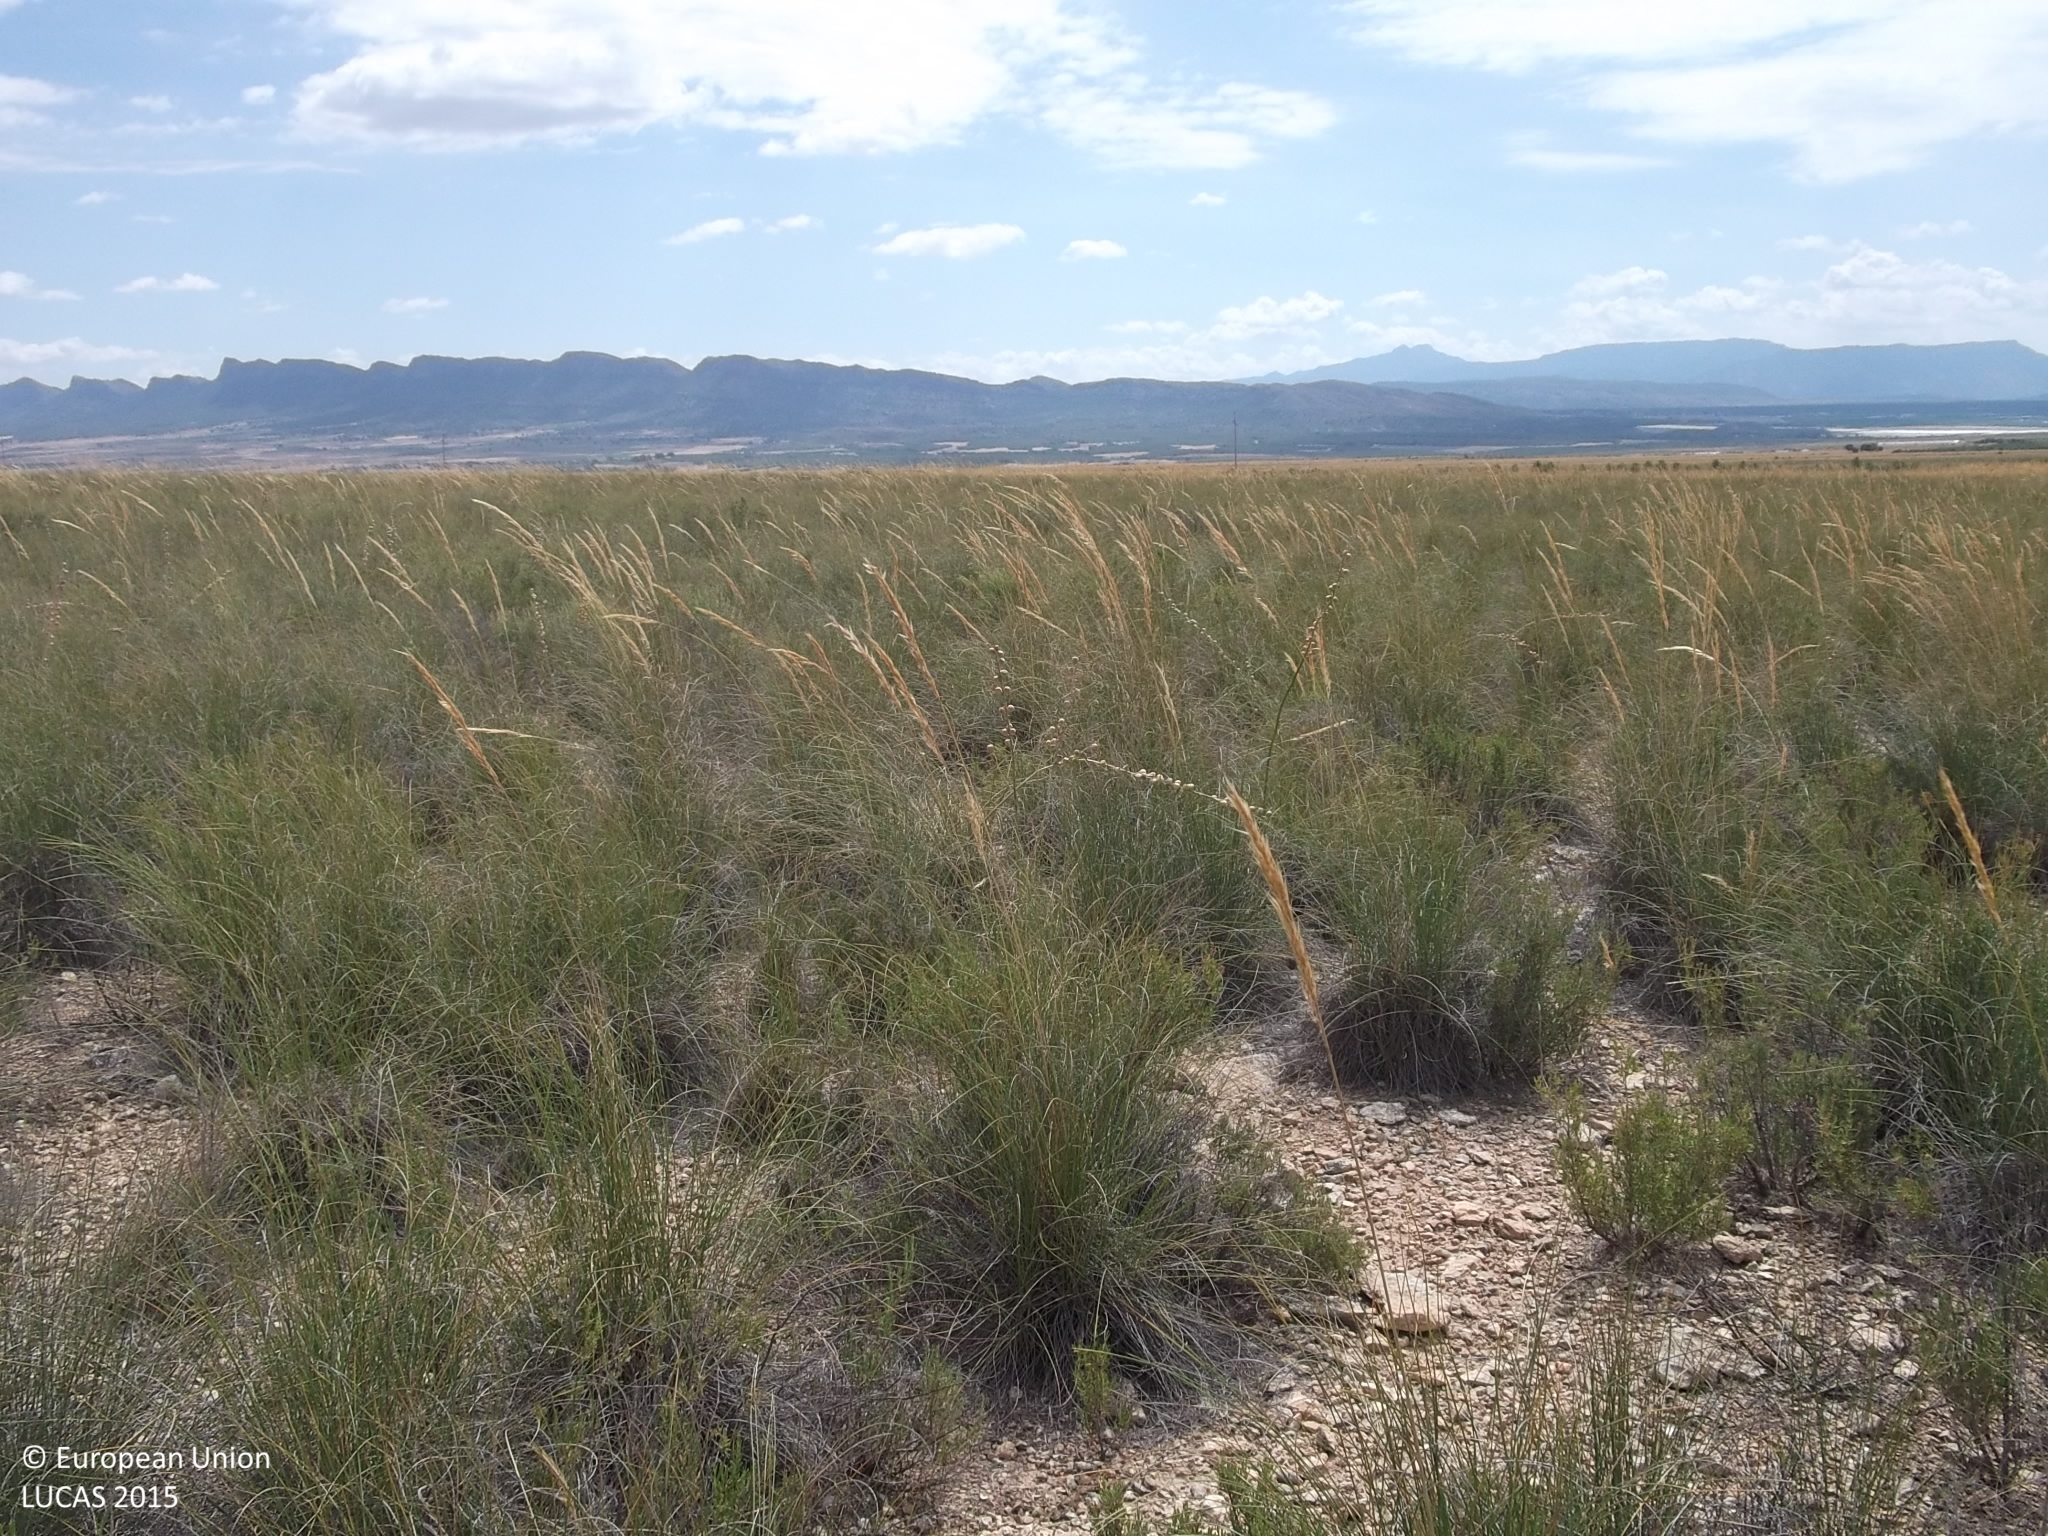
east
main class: Shrubland
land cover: Shrubland without tree cover
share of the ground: 25 - 50 %
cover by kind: shrubs 40 %, herbaceous plants 30 %, consolidated bare surface 30 %
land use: Semi-natural and natural areas not in use
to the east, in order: Shrubland without tree cover; Tracks; Shrubland without tree cover; Tracks; Shrubland without tree cover
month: May
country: ES
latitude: 38.3475
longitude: -1.4896
